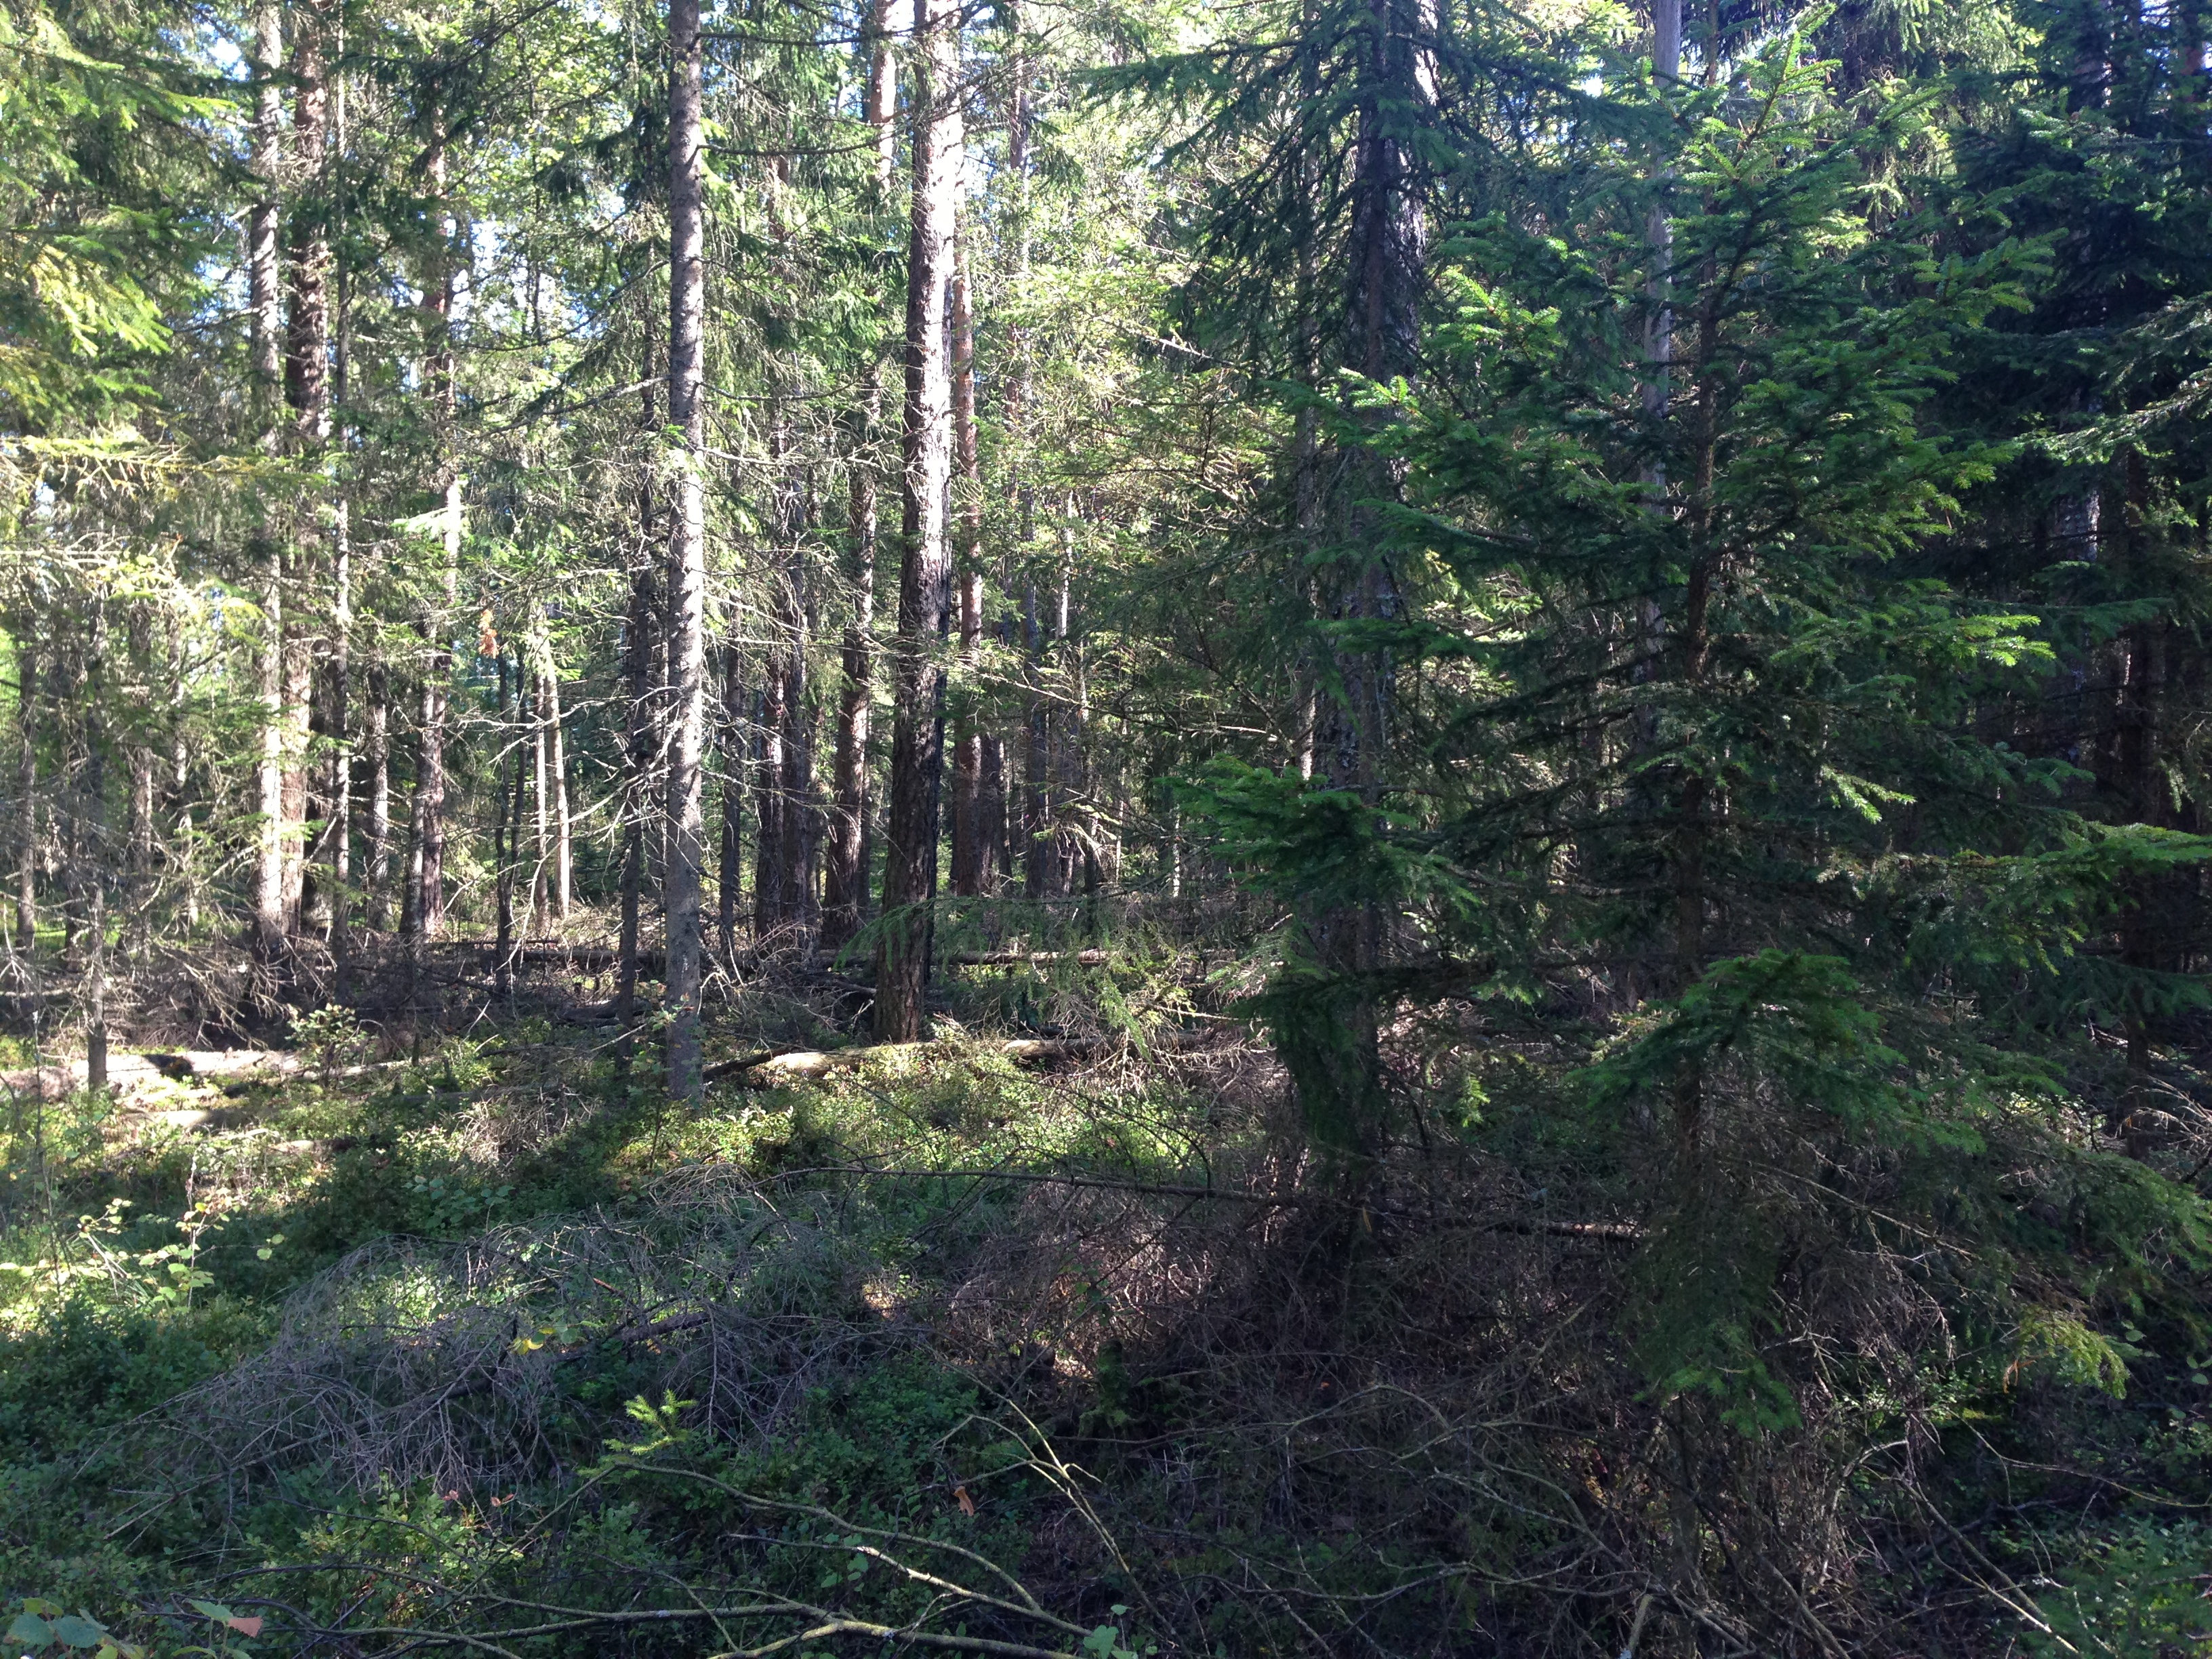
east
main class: Woodland
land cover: Pine dominated coniferous woodland
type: boreal forest
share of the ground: 50 - 75 %
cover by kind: coniferous forest trees 75 %, shrubs 25 %
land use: Forestry
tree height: > 5 m
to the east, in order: Pine dominated coniferous woodland; Spruce dominated coniferous woodland; Ditches and canals; Spruce dominated coniferous woodland; Ditches and canals; Spruce dominated coniferous woodland
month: September
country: SE
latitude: 57.1722
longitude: 13.2543
